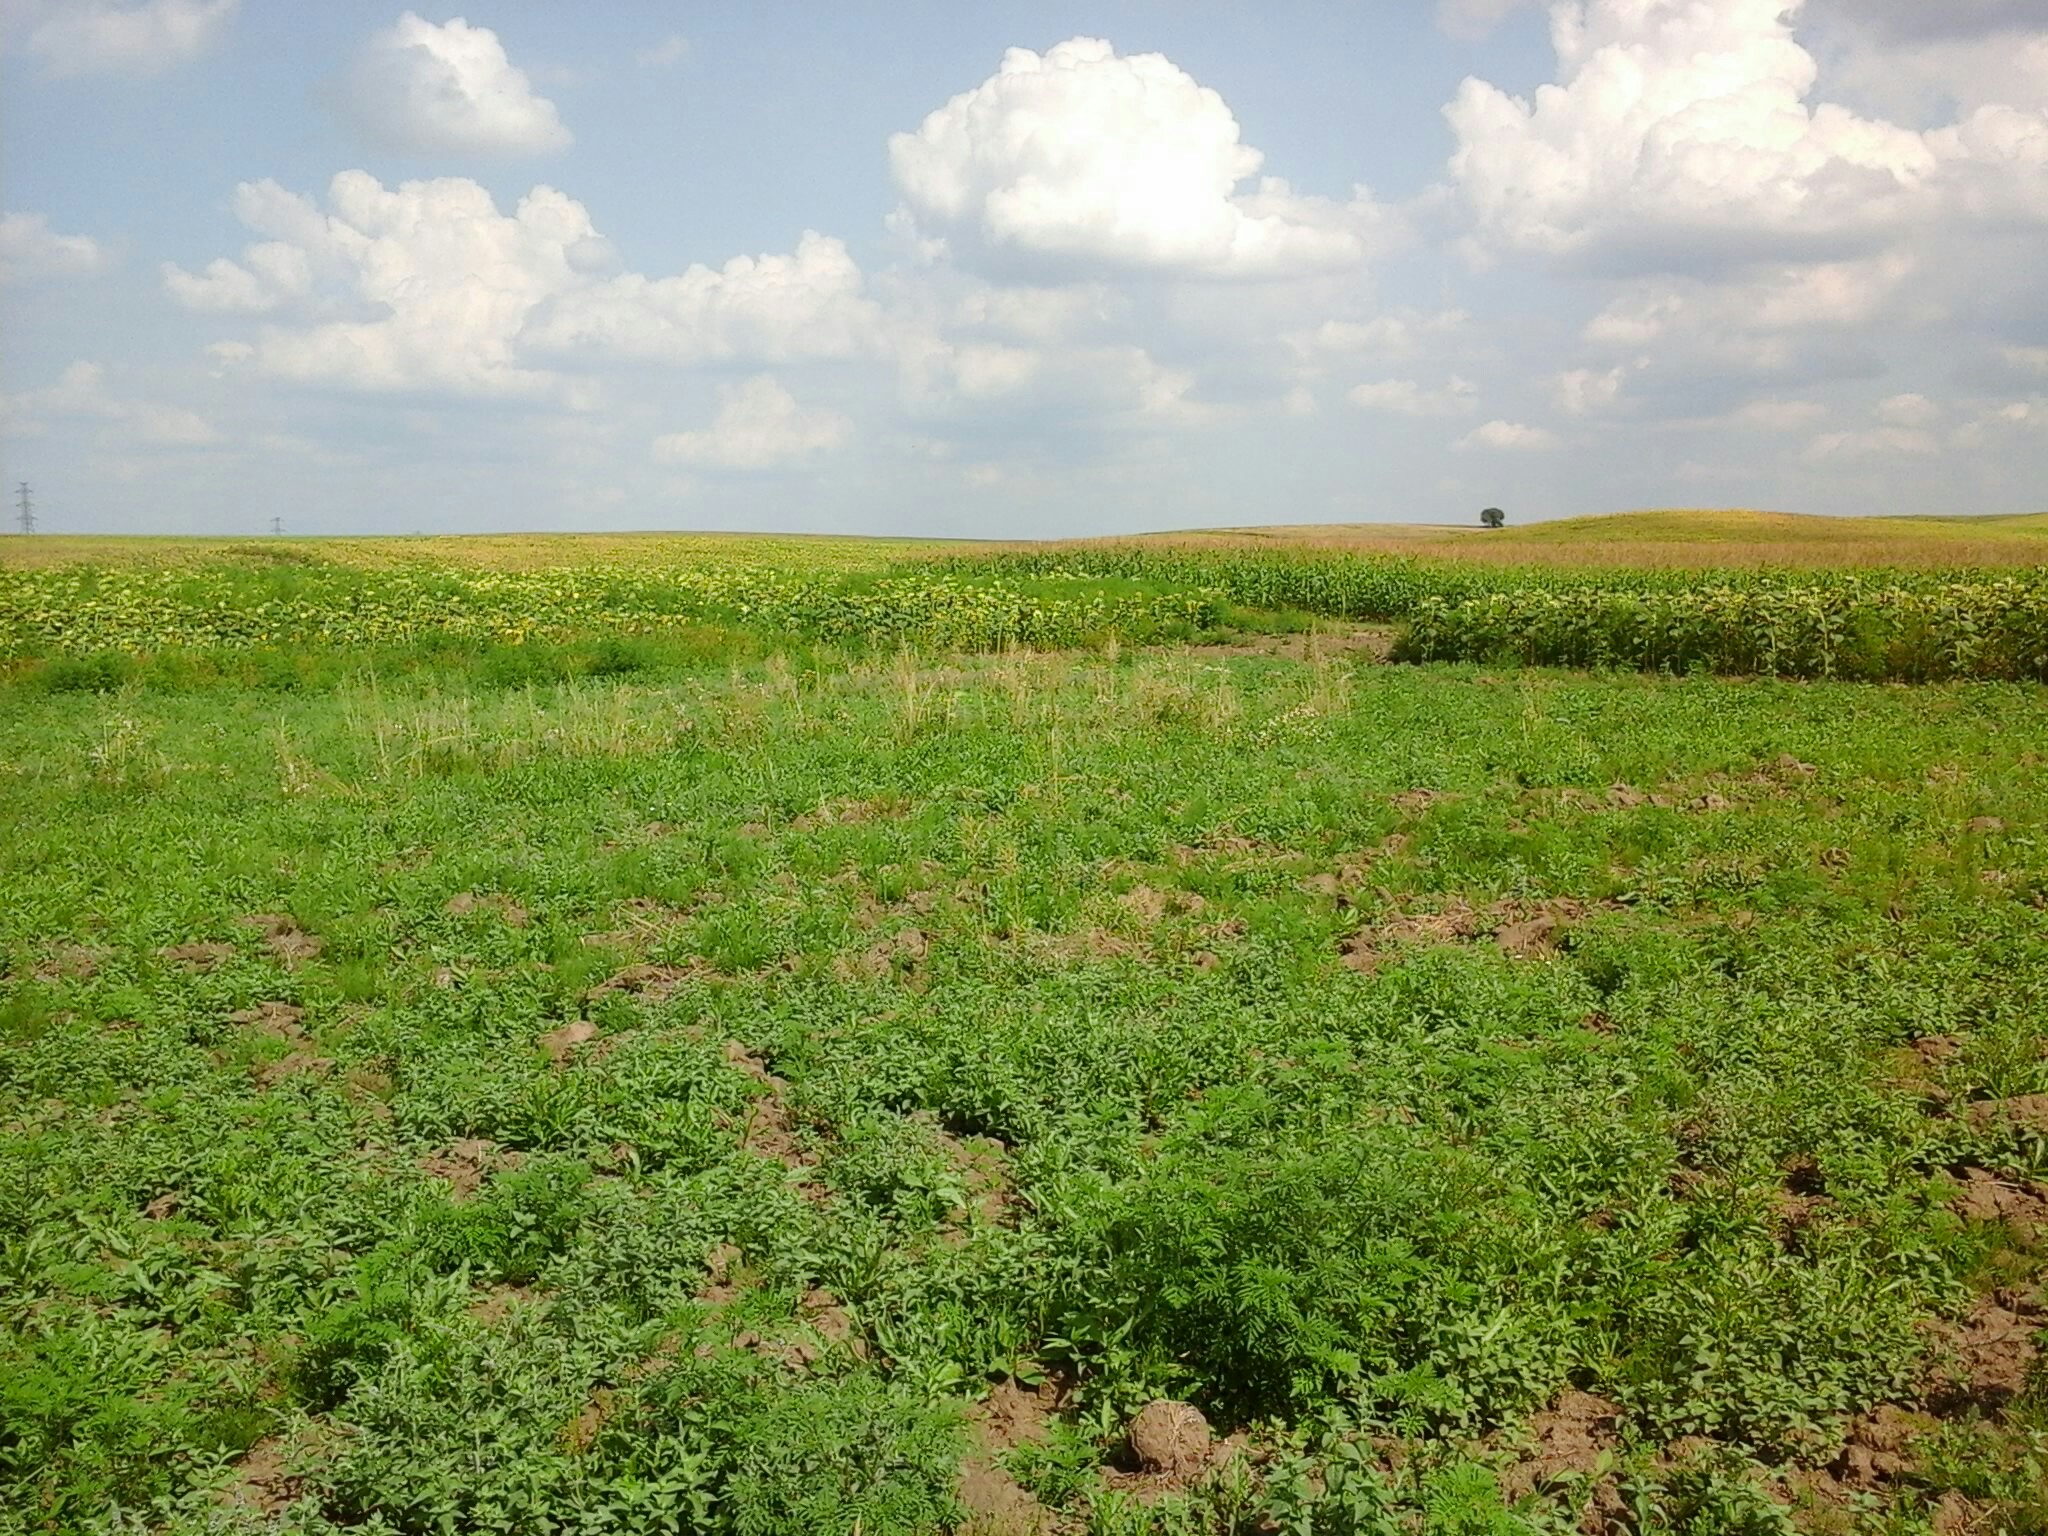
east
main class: Grassland
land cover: Spontaneously vegetated surfaces
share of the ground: > 75 %
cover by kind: herbaceous plants 100 %
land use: Fallow land
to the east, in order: Spontaneously vegetated surfaces; Sunflower; Tracks; Maize; Sunflower
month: August
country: HU
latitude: 47.5015
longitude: 18.2030
